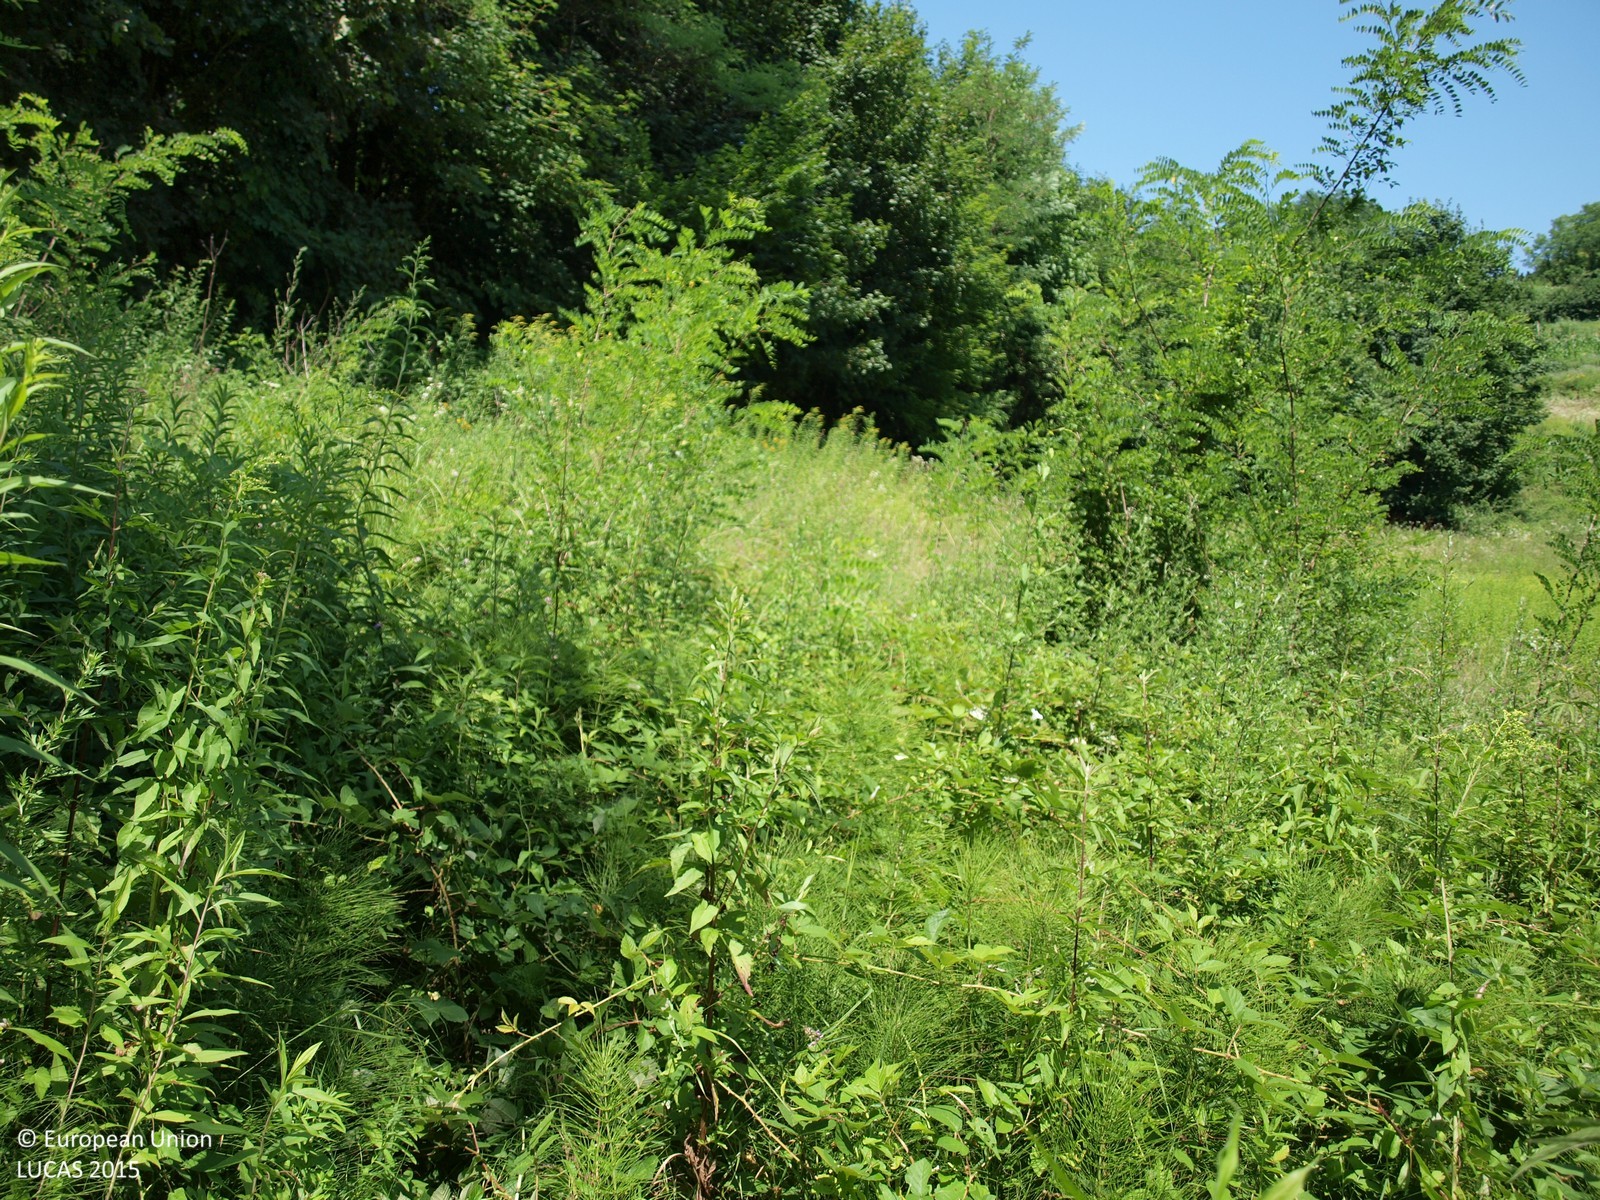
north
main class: Shrubland
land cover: Shrubland with sparse tree cover
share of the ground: > 75 %
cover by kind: shrubs 85 %, herbaceous plants 10 %, broadleaved forest trees 5 %
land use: Semi-natural and natural areas not in use
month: July
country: HR
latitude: 46.0781
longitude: 15.9337
